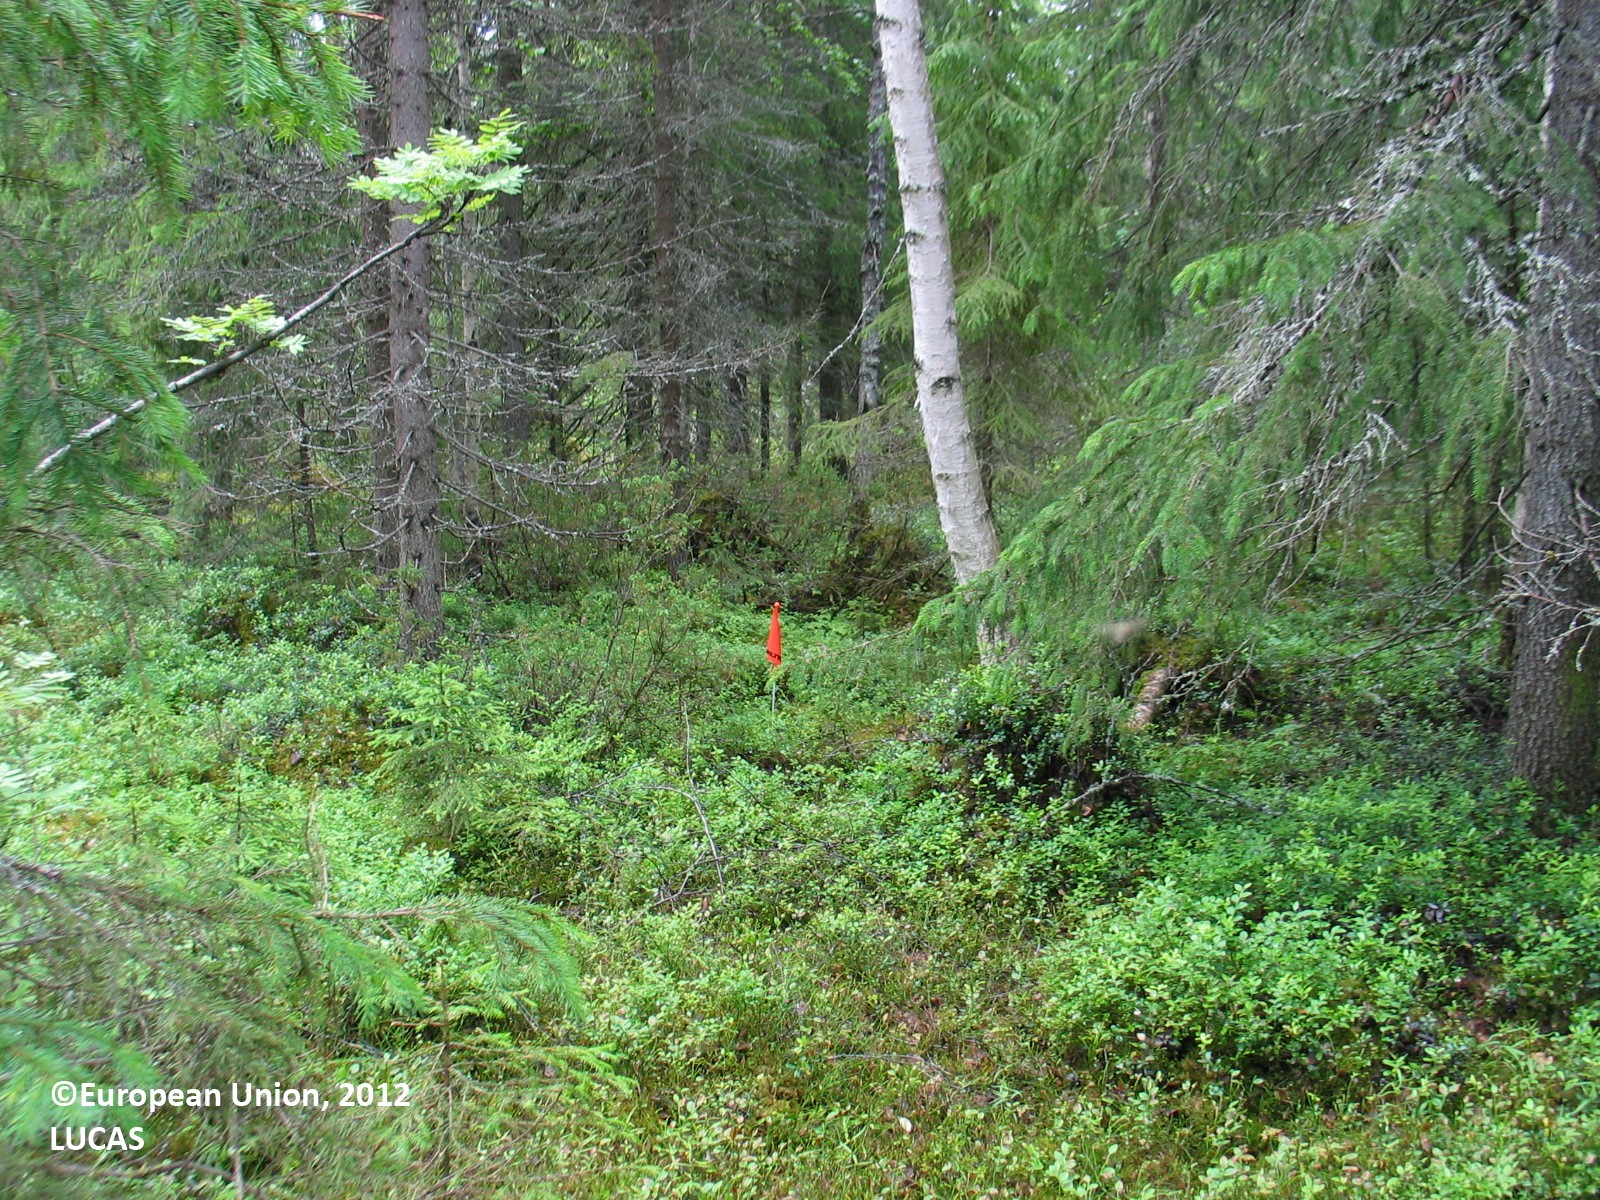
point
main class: Woodland
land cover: Spruce dominated coniferous woodland
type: boreal forest
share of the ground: 50 - 75 %
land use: Forestry
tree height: > 5 m
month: July
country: FI
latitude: 65.9839
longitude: 25.0571
